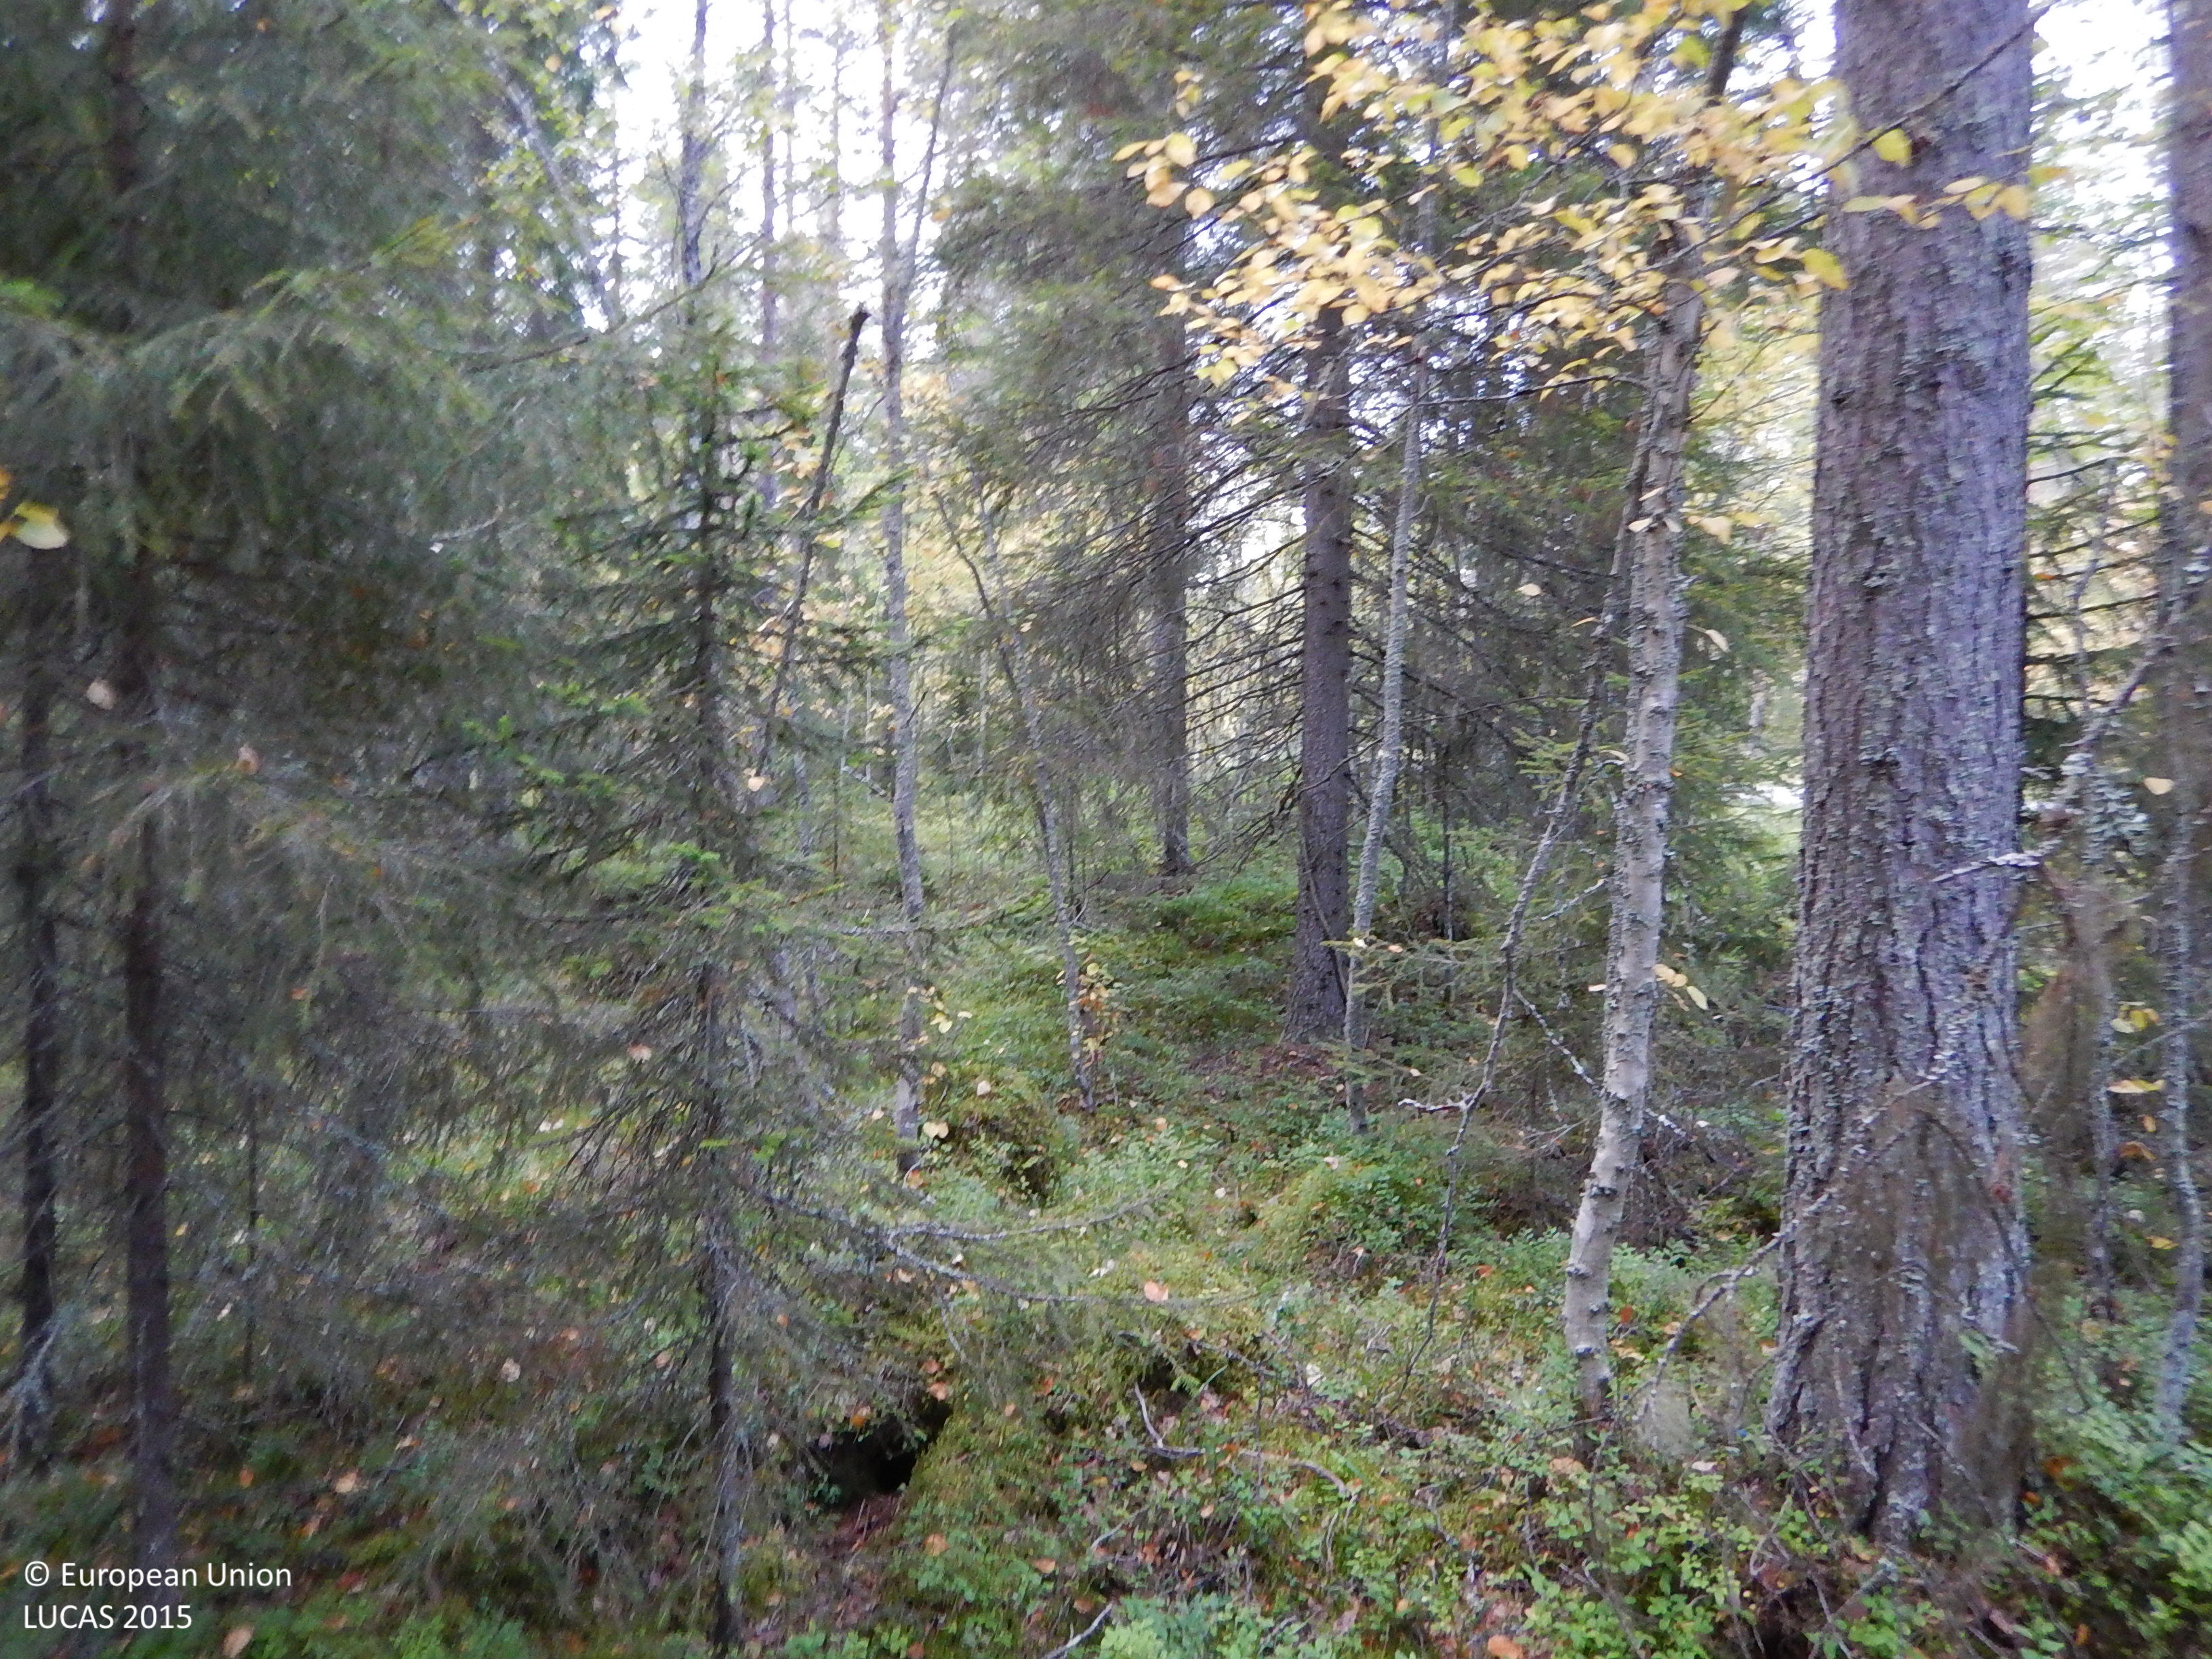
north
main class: Woodland
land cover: Other coniferous woodland
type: boreal forest
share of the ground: 50 - 75 %
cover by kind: coniferous forest trees 45 %, shrubs 25 %, broadleaved forest trees 15 %, lichens and mosses 15 %
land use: Forestry
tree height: > 5 m
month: September
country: SE
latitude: 64.7490
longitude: 20.1201
